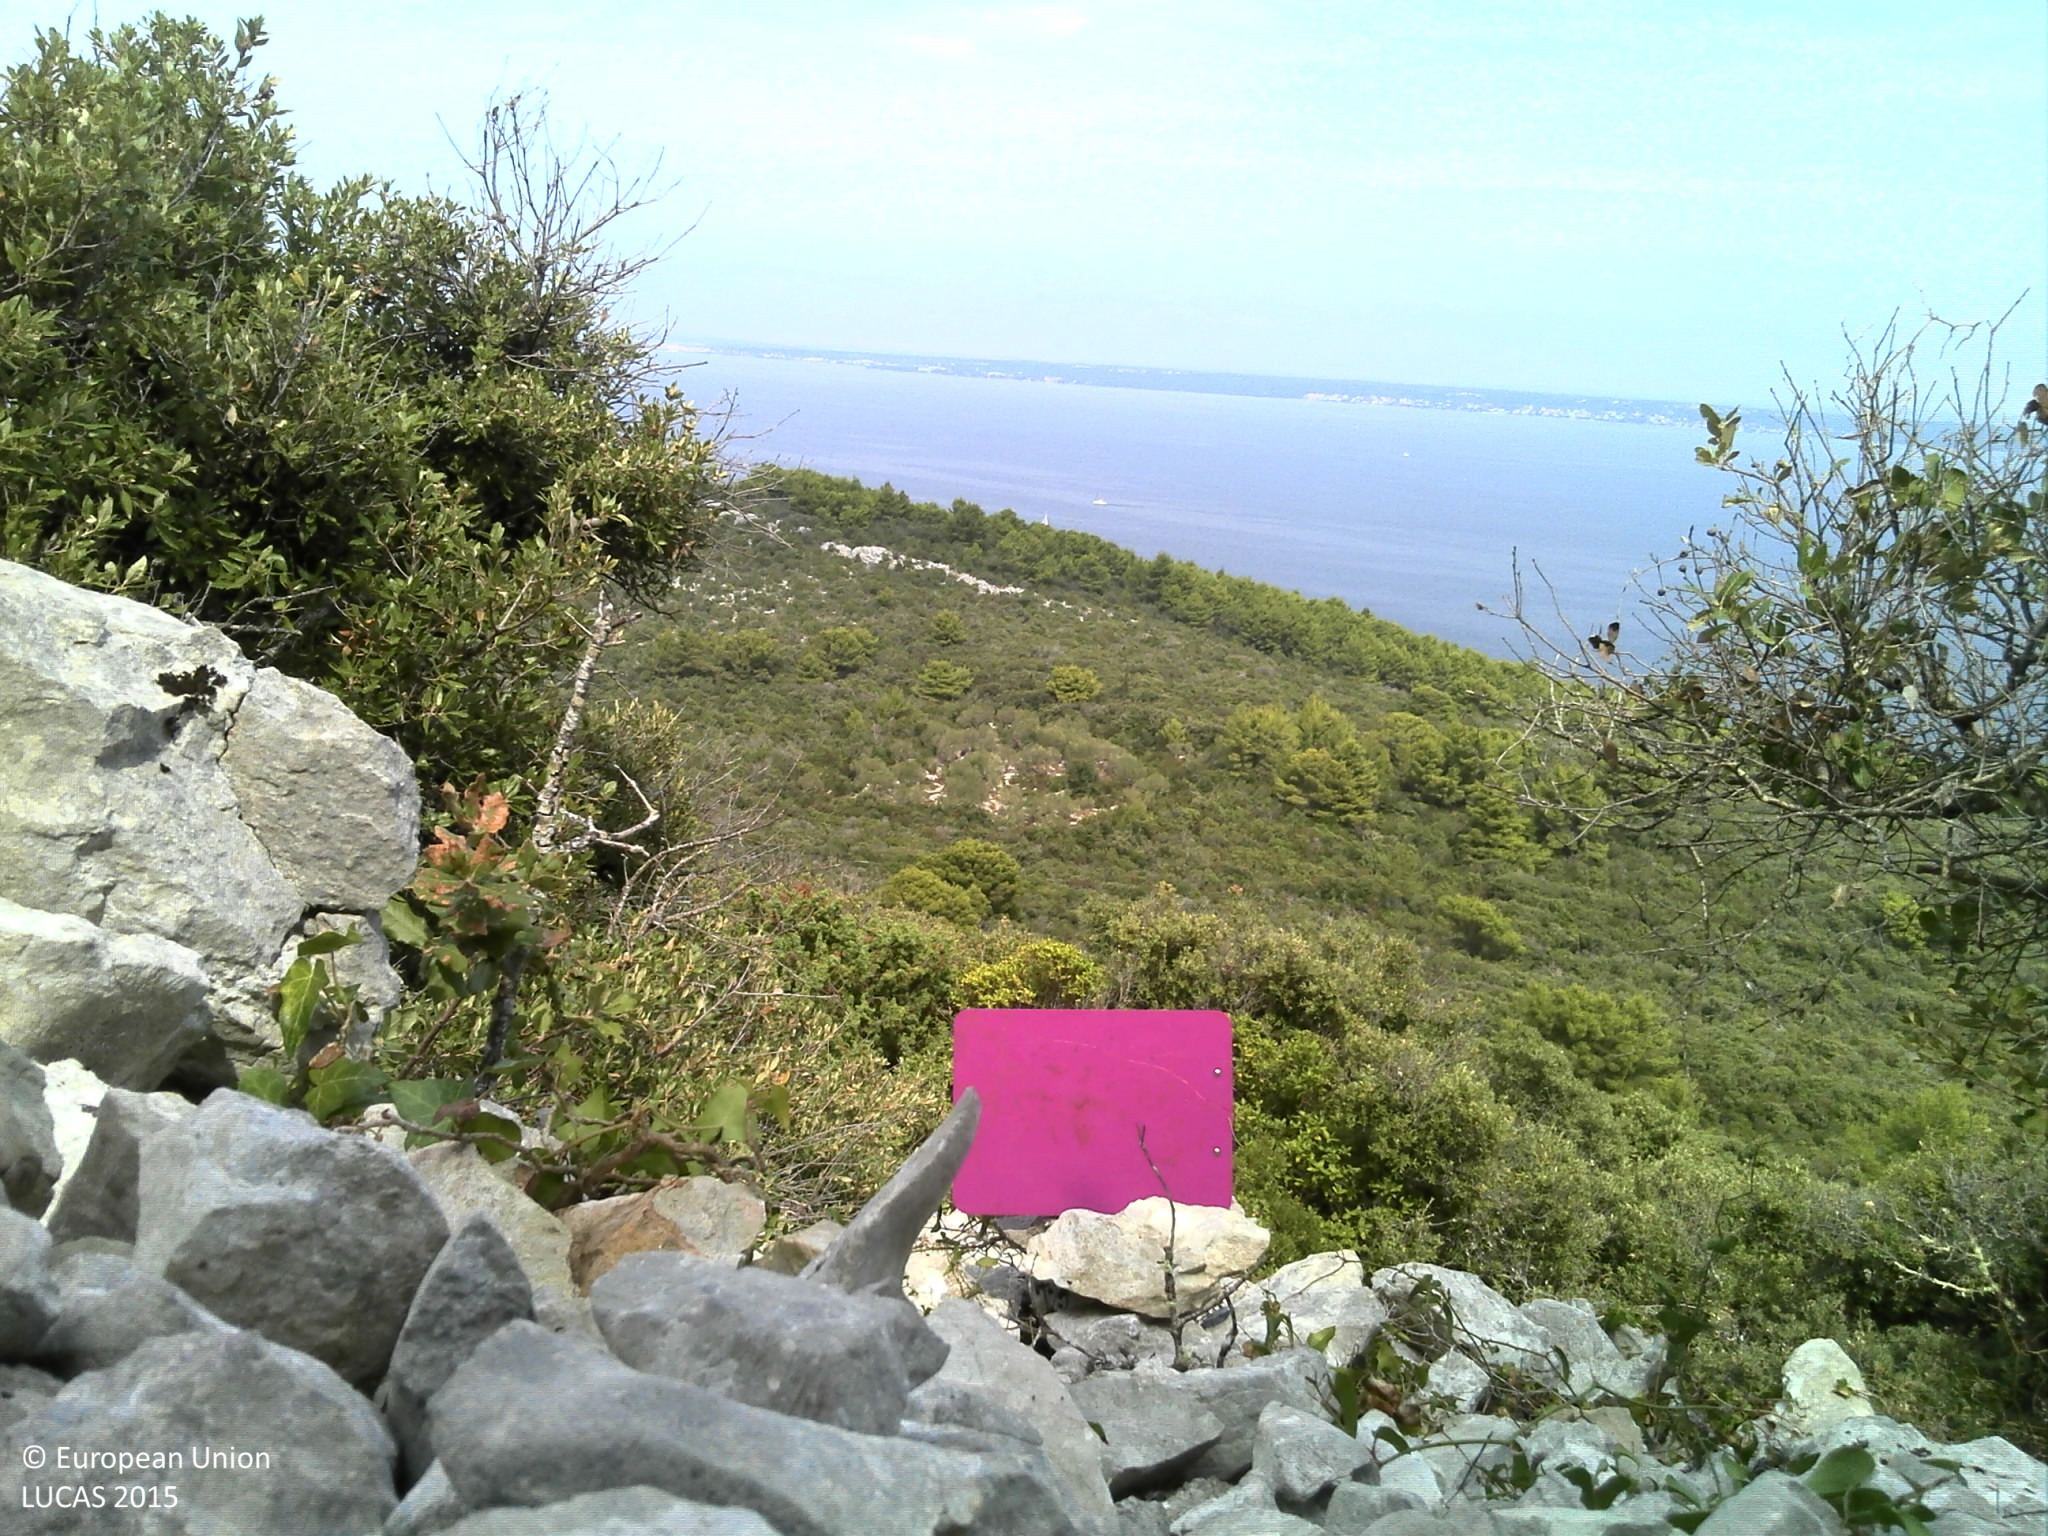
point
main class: Shrubland
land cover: Shrubland with sparse tree cover
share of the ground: > 75 %
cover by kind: shrubs 80 %, consolidated bare surface 10 %, broadleaved forest trees 5 %, herbaceous plants 5 %
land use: Semi-natural and natural areas not in use
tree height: < 5 m
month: September
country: HR
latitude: 44.1154
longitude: 15.1274
